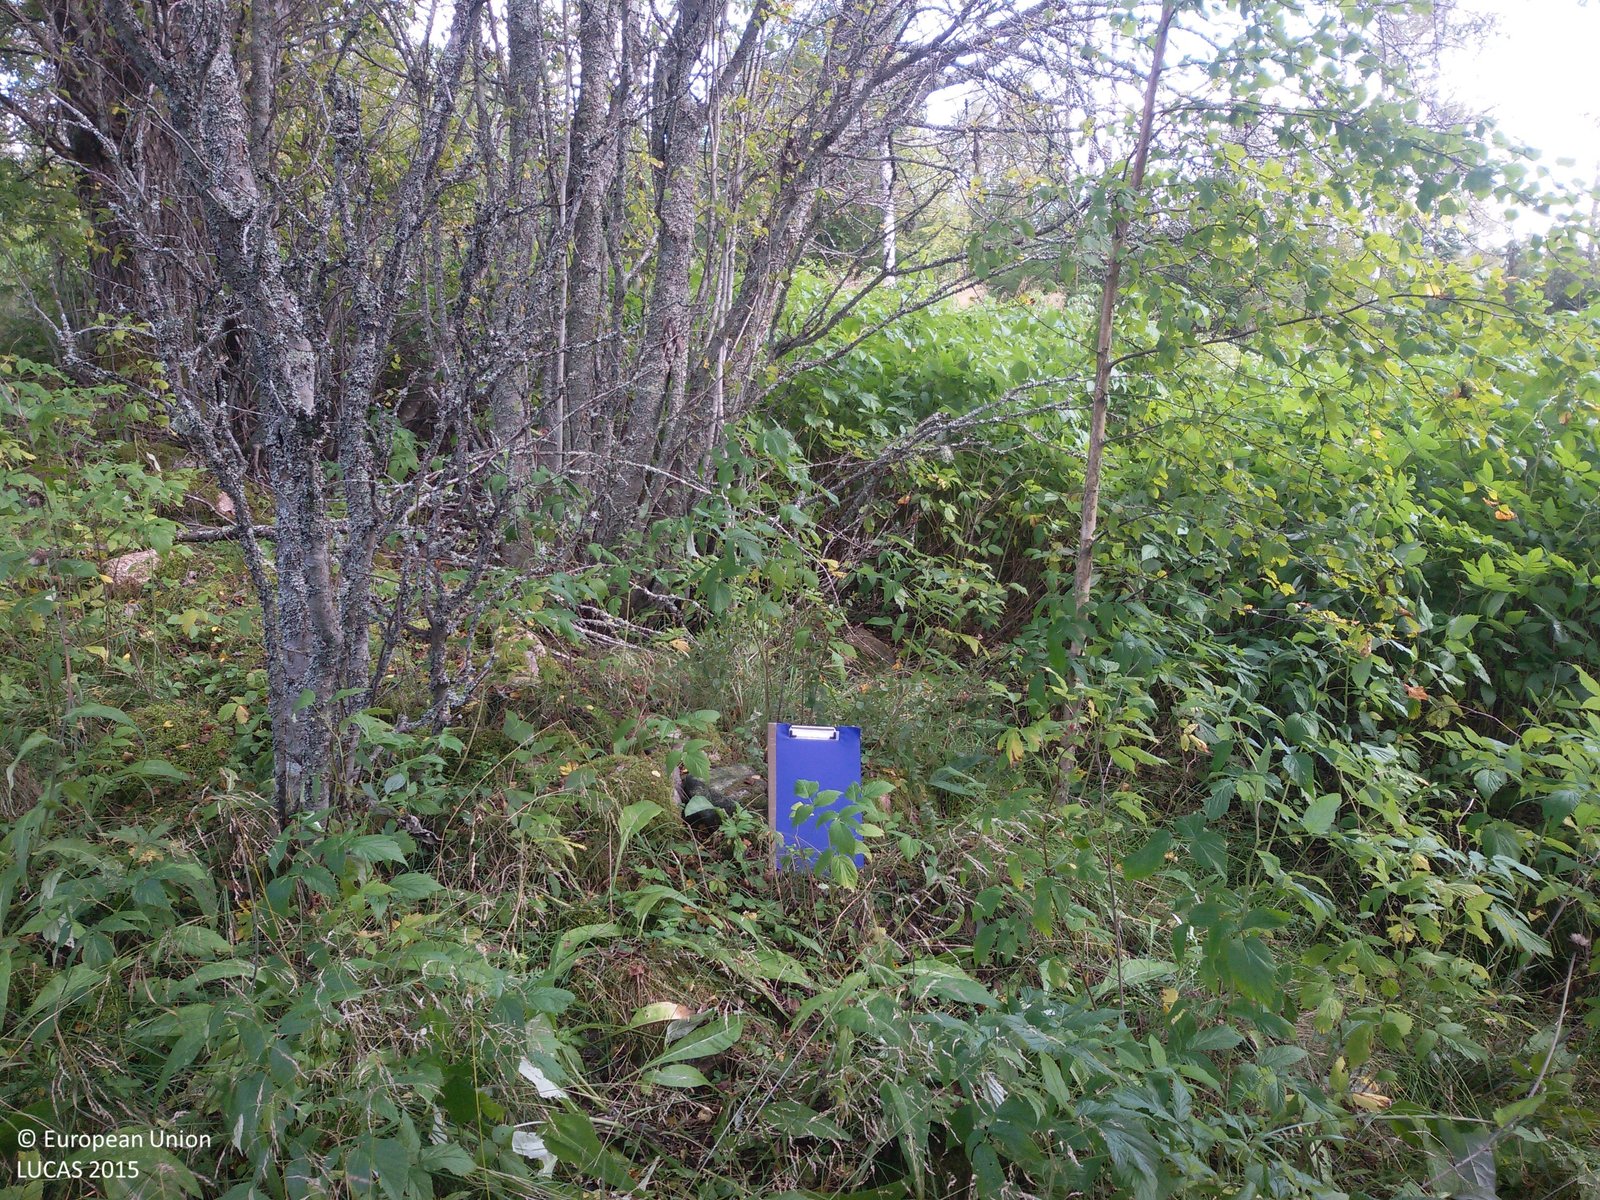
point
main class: Woodland
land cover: Broadleaved woodland
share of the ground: > 75 %
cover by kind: broadleaved forest trees 80 %, herbaceous plants 20 %
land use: Semi-natural and natural areas not in use
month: September
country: SE
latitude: 60.7546
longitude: 15.1431
